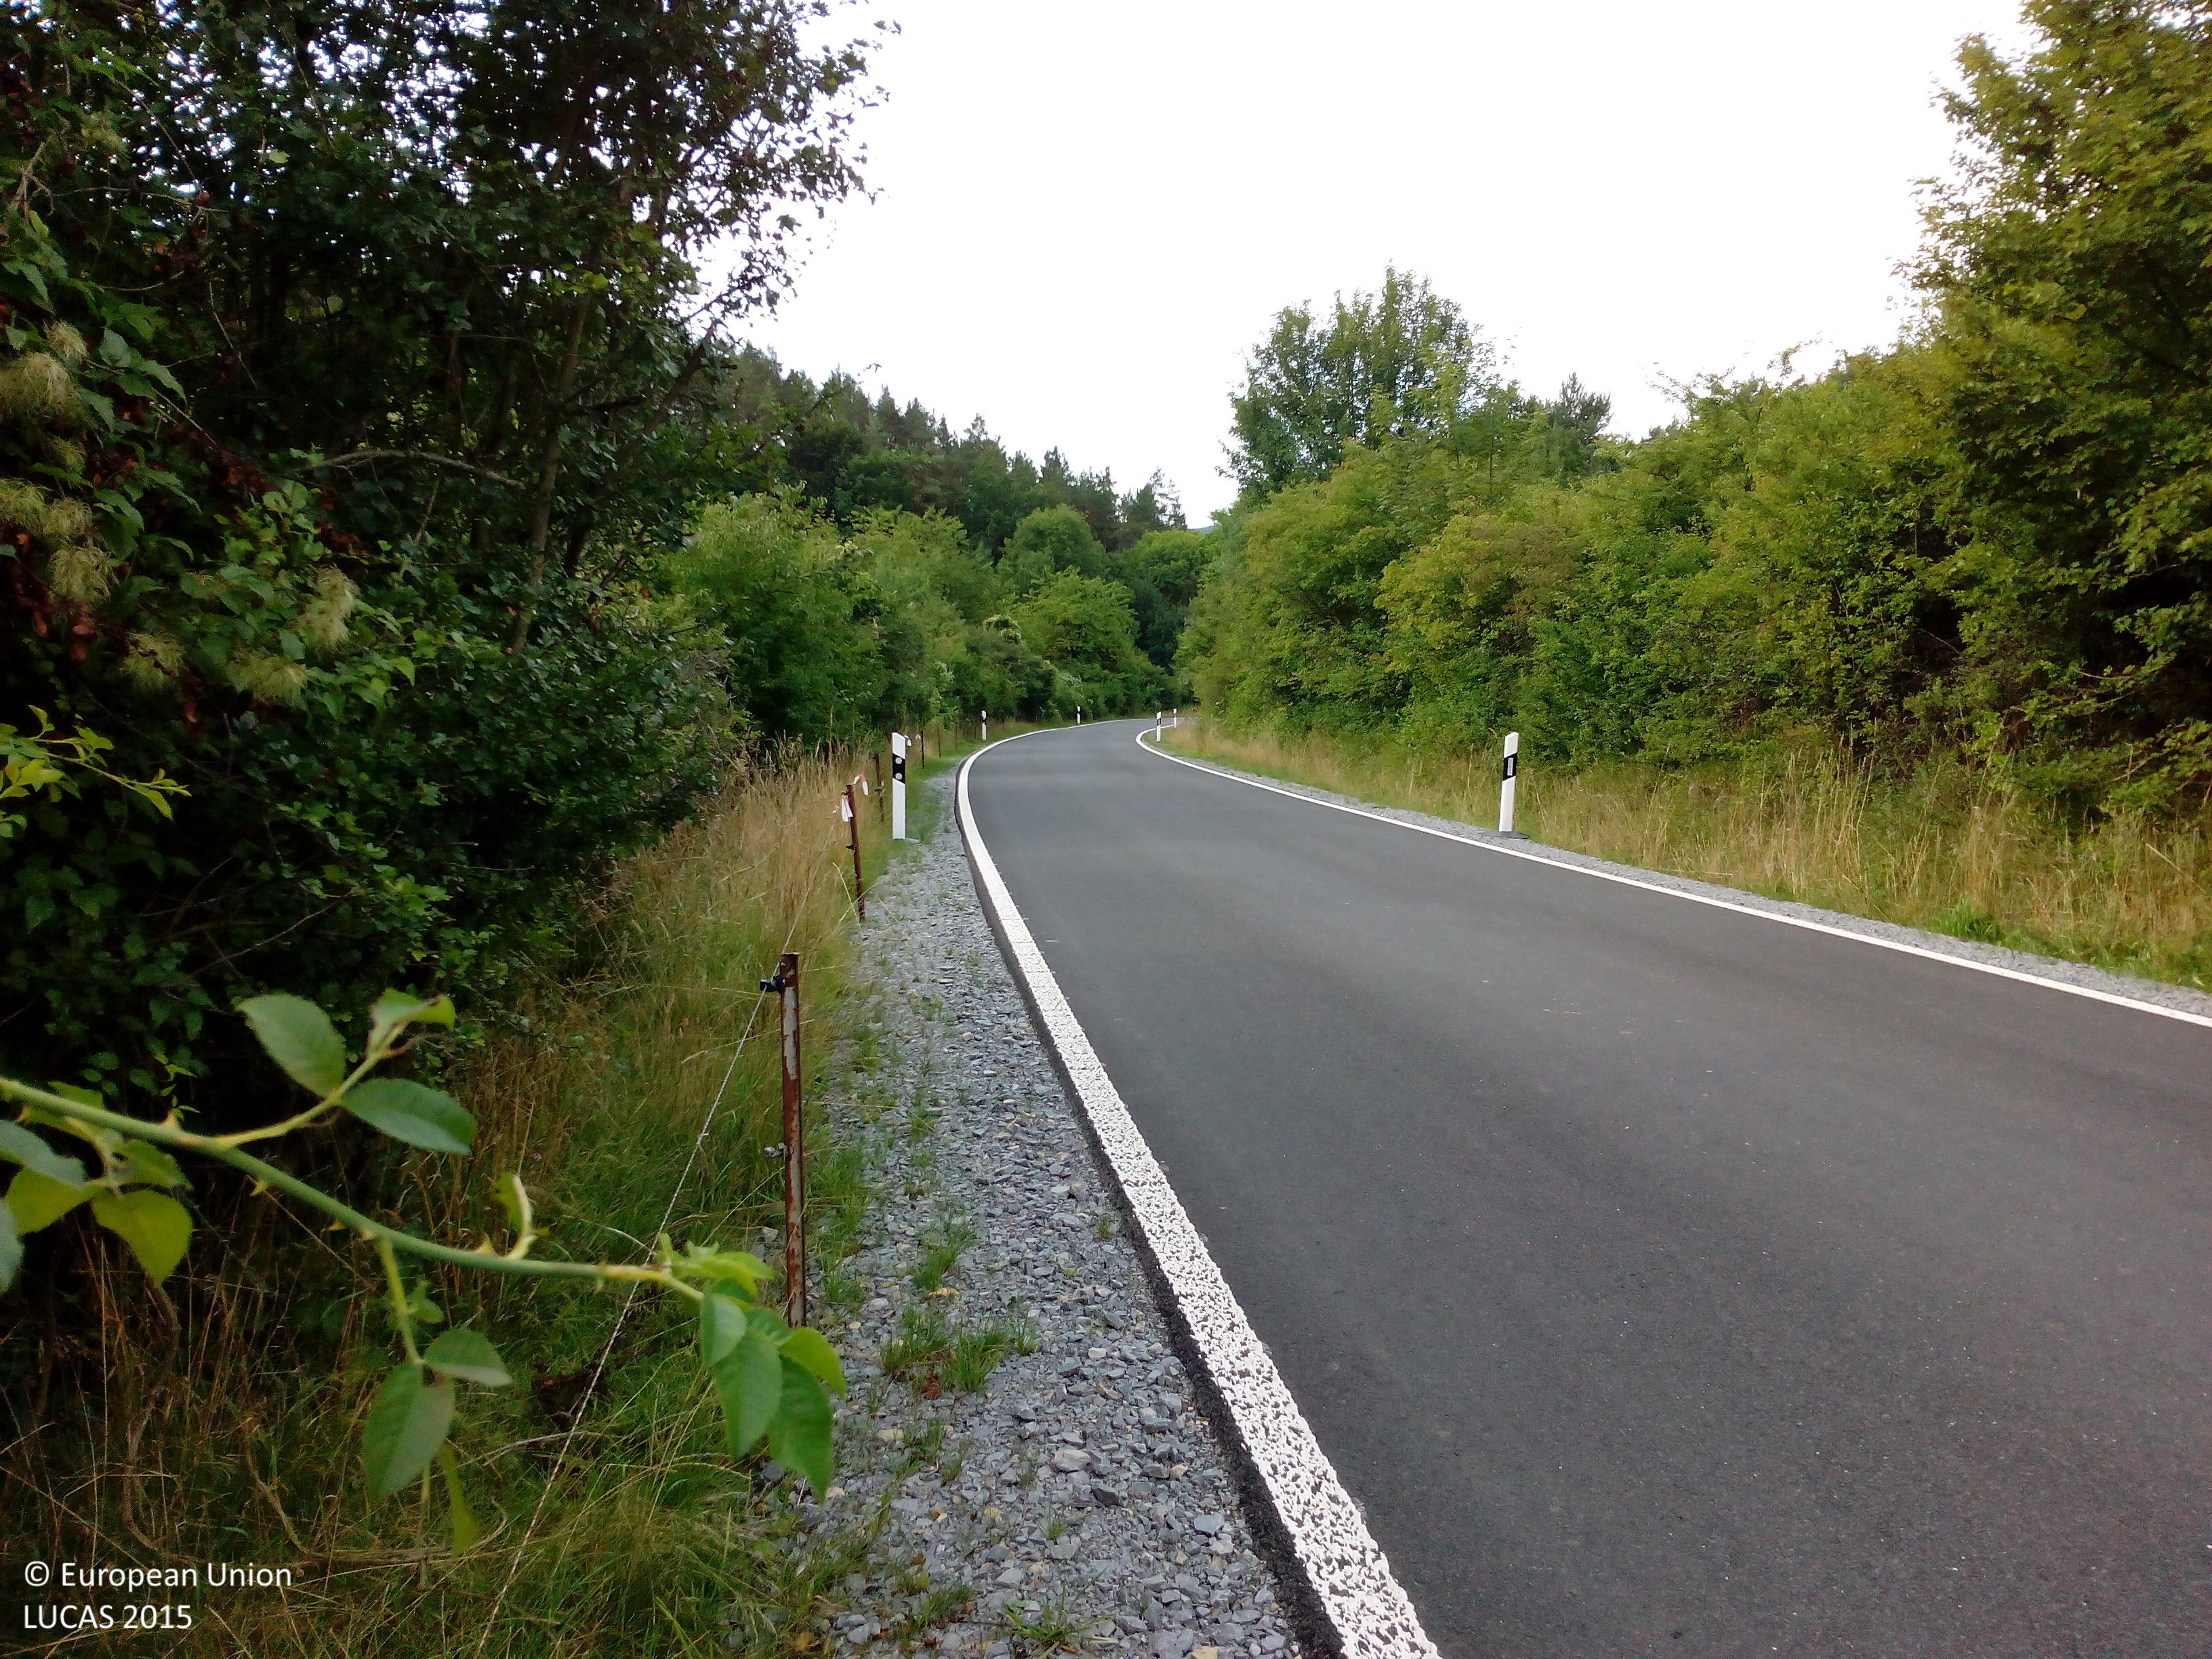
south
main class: Grassland
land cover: Grassland without tree/shrub cover
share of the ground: > 75 %
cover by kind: herbaceous plants 95 %, shrubs 5 %
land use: Agriculture (excluding fallow land and kitchen gardens)
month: August
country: DE
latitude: 51.1368
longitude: 10.2715
